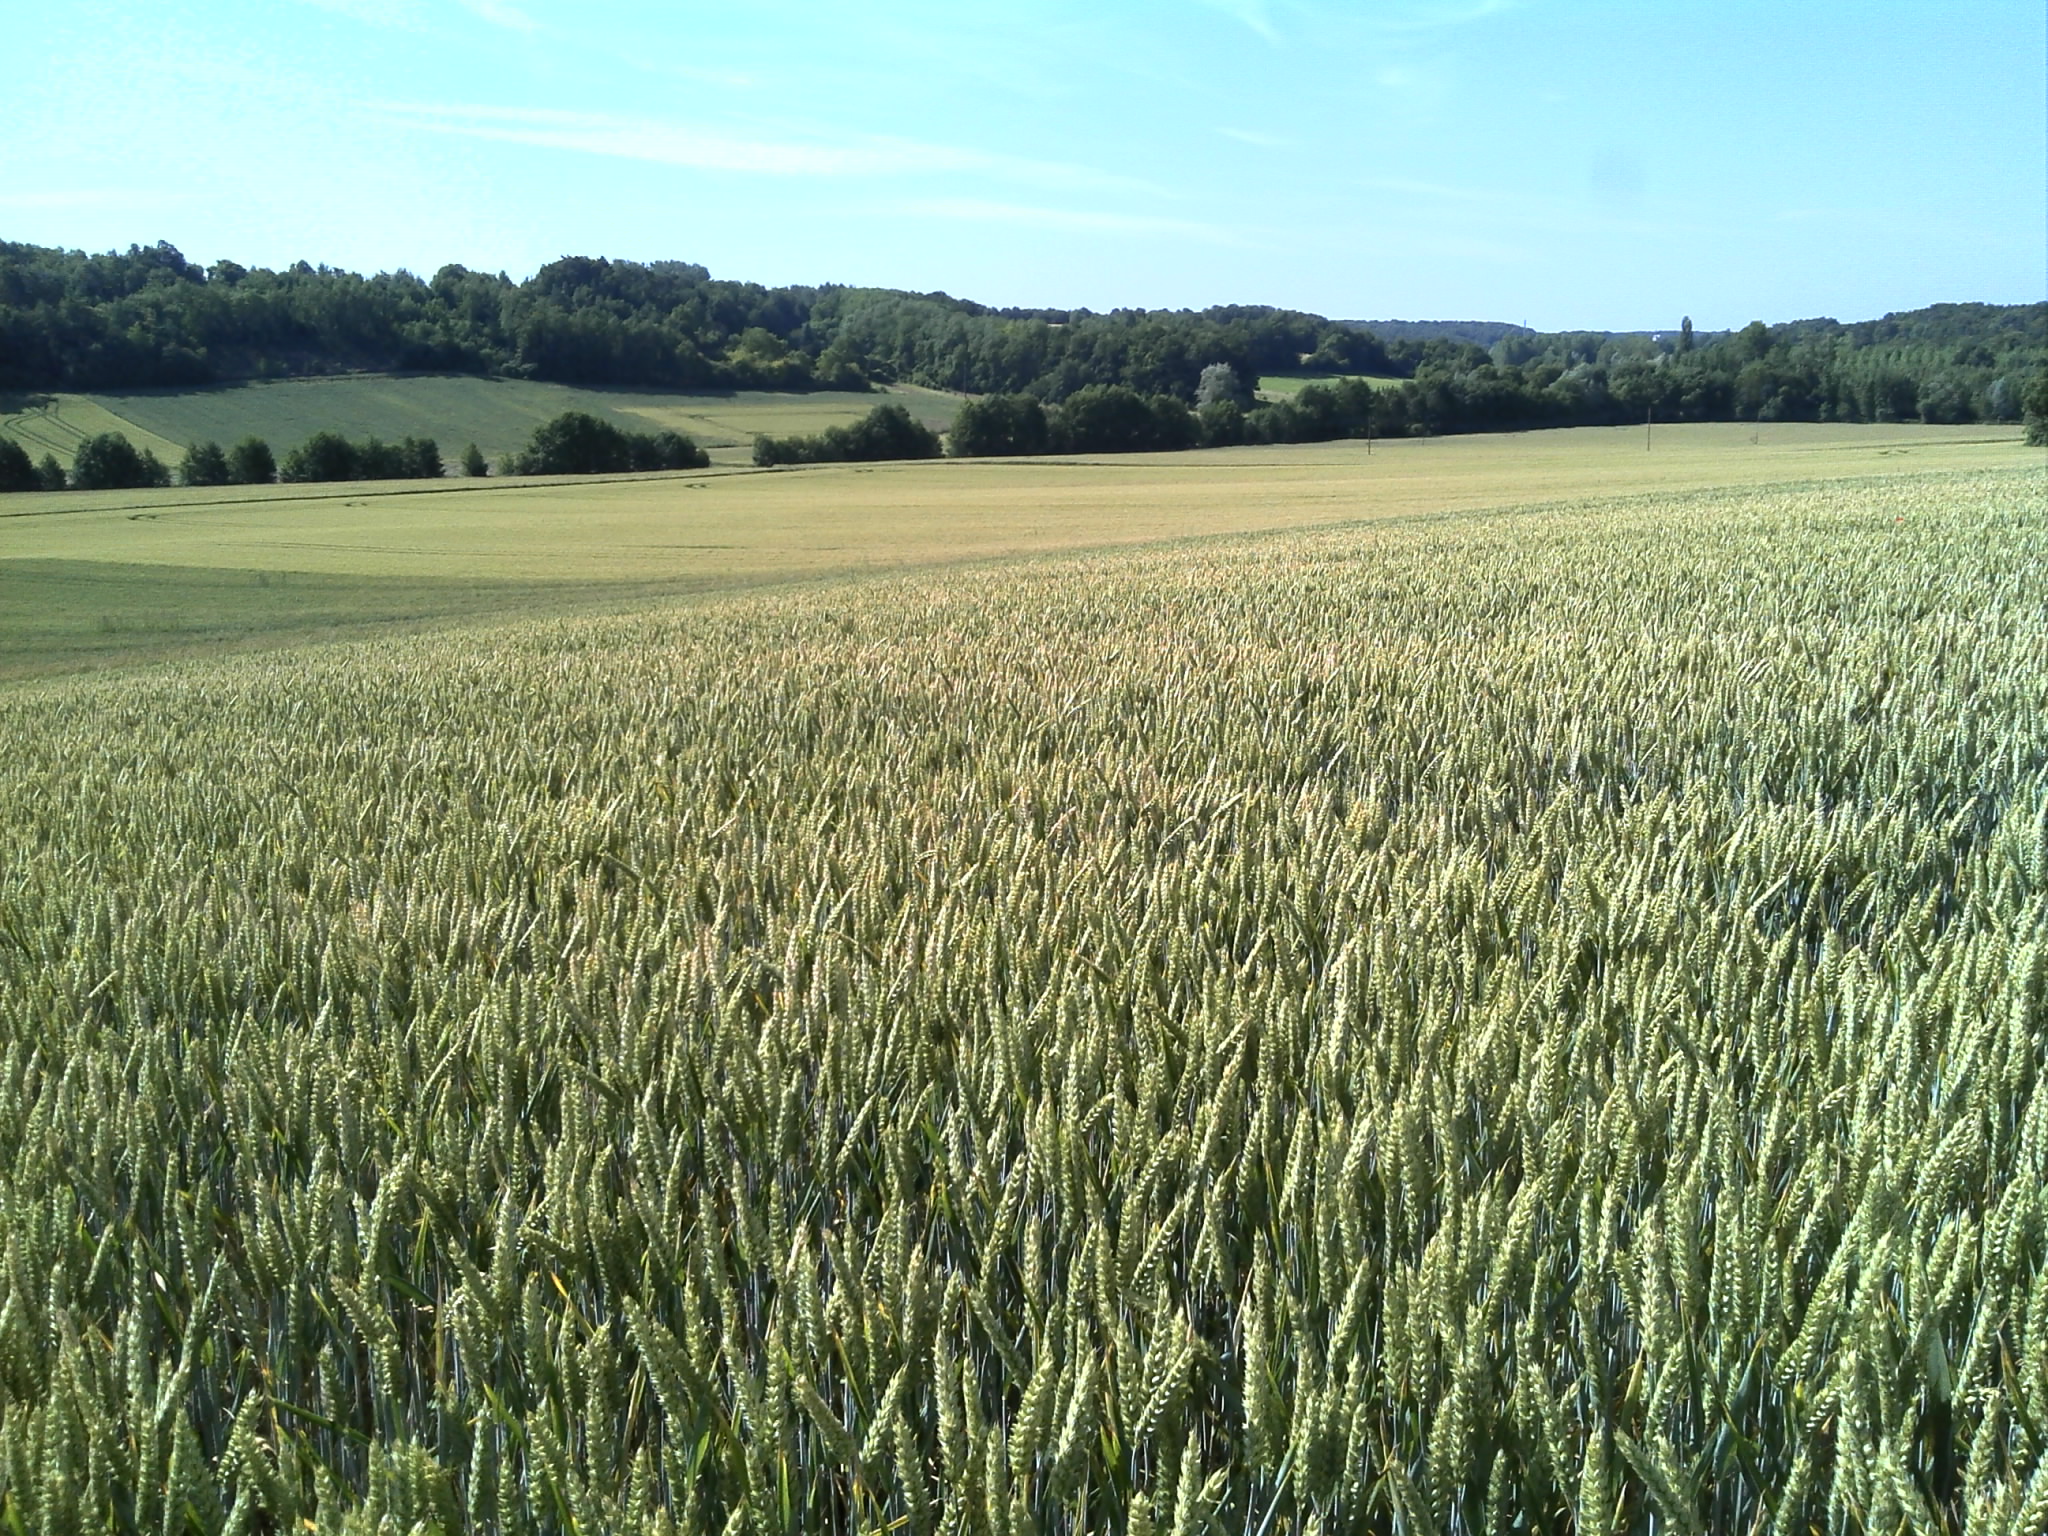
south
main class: Cropland
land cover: Common wheat
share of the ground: > 75 %
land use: Agriculture (excluding fallow land and kitchen gardens)
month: June
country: FR
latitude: 47.2008
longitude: 1.4195
